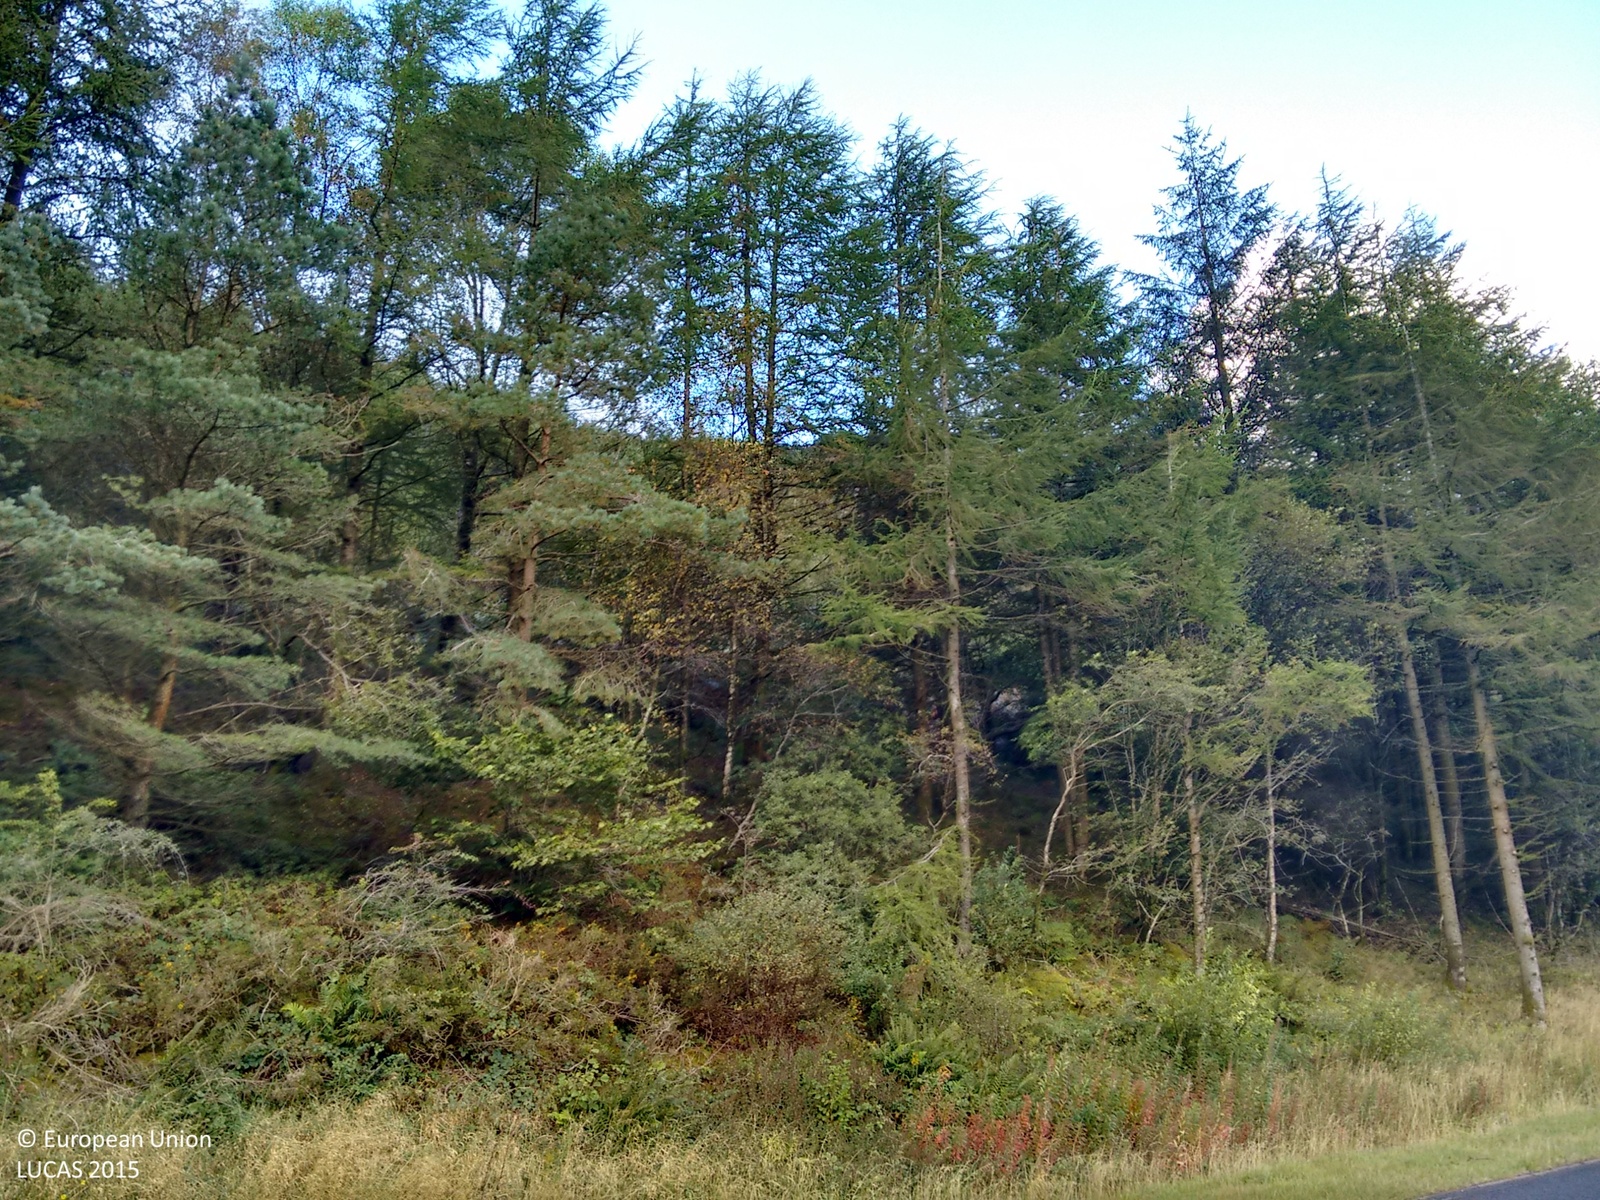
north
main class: Woodland
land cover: Other coniferous woodland
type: exotic forest
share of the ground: > 75 %
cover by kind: coniferous forest trees 100 %
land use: Forestry
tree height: > 5 m
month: September
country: GB
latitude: 52.8163
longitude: -3.7244
